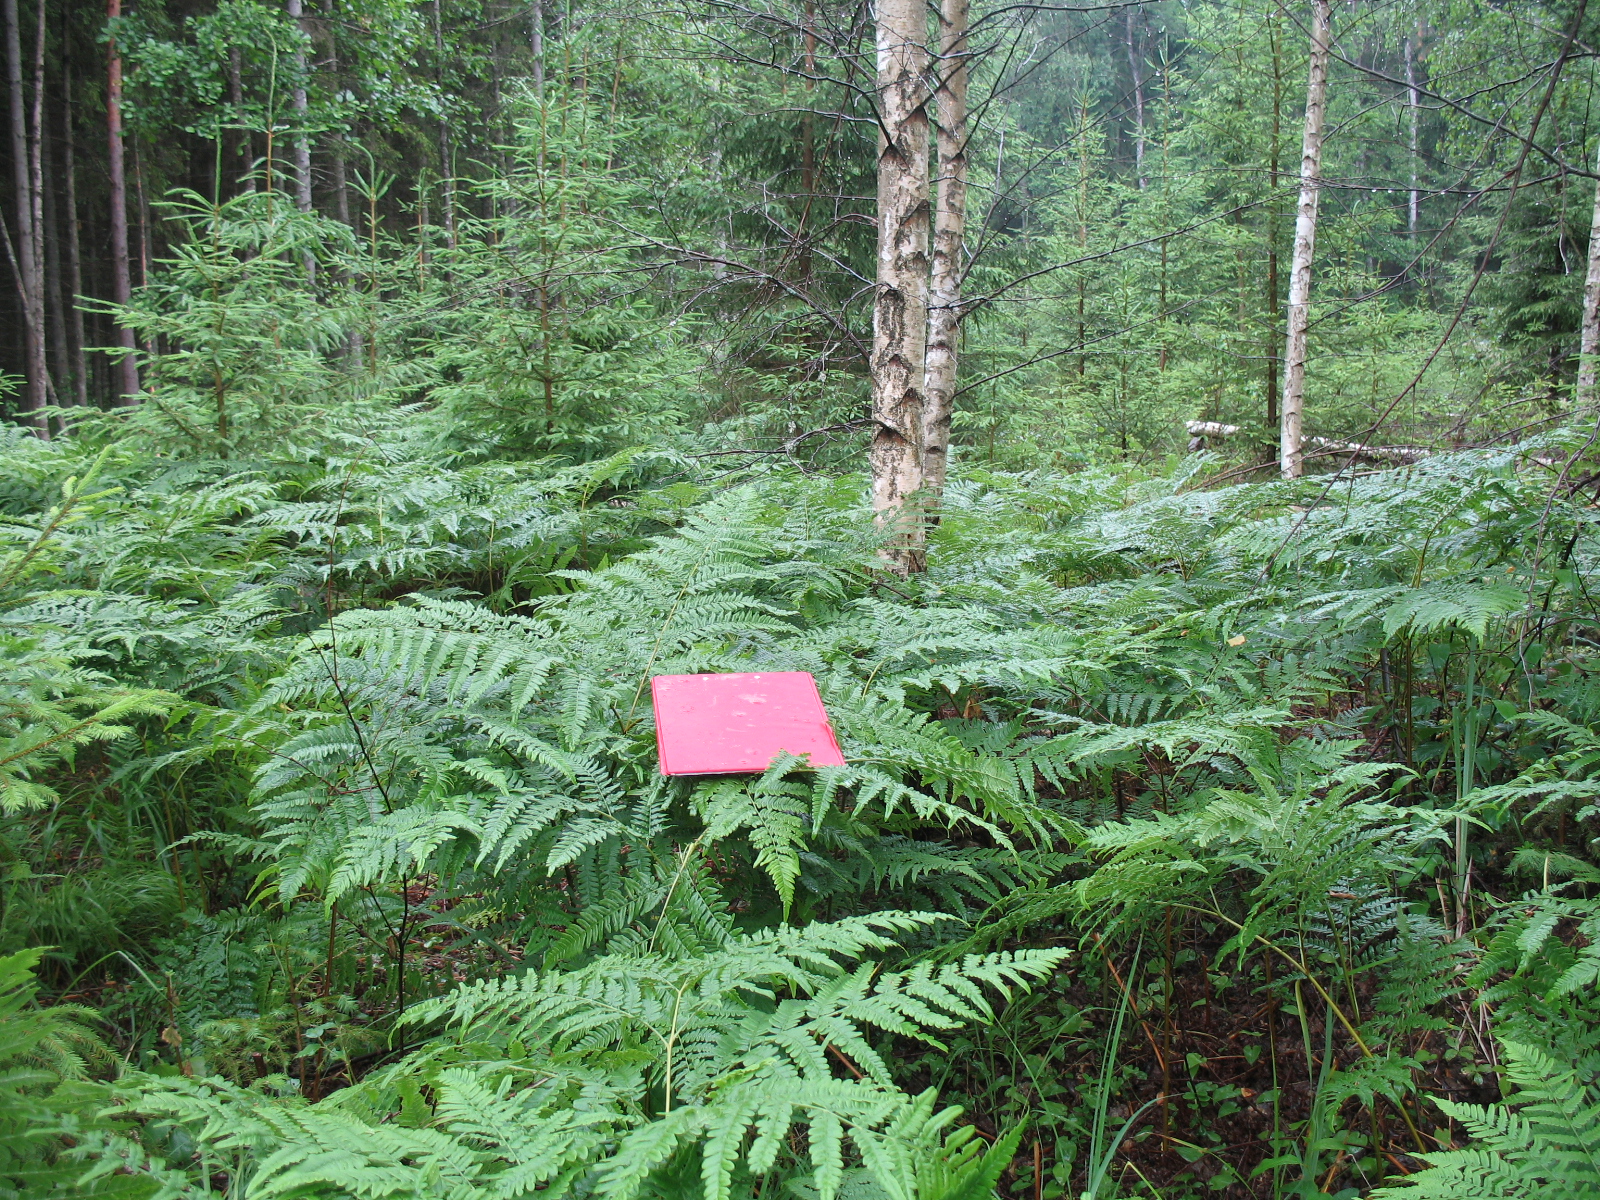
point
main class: Woodland
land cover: Spruce dominated mixed woodland
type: hemiboreal forest and nemoral coniferous forest and mixed broadleaved-coniferous forest
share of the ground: 50 - 75 %
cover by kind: broadleaved forest trees 40 %, herbaceous plants 40 %, coniferous forest trees 20 %
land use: Forestry
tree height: > 5 m
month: July
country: LV
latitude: 56.7354
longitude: 23.7948
